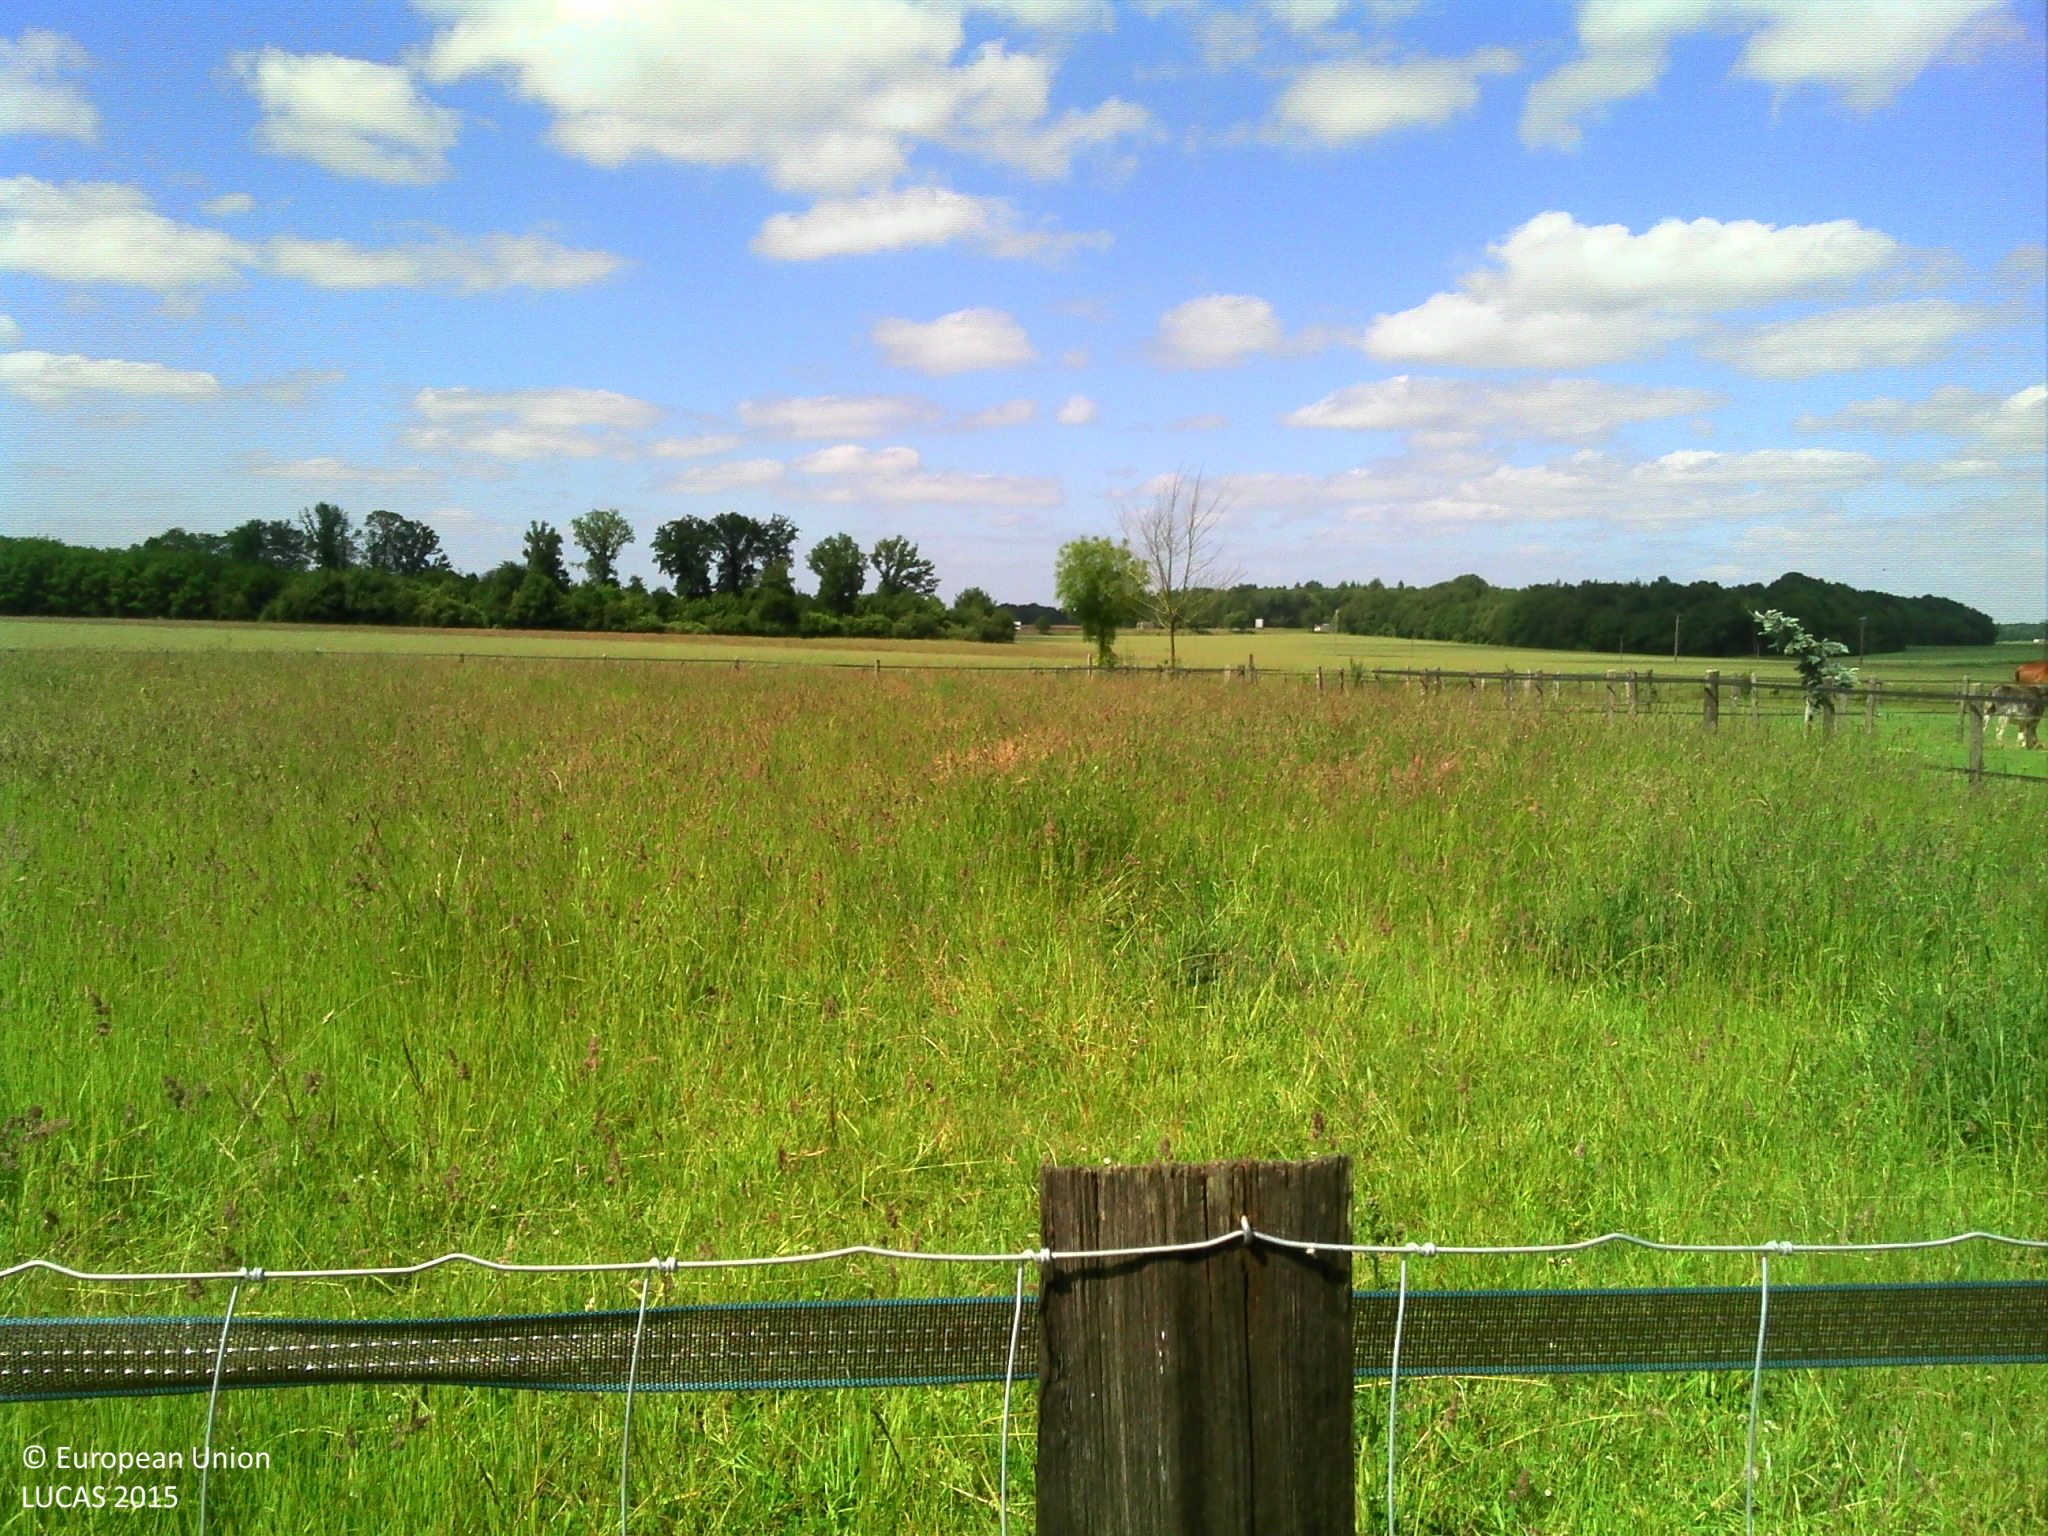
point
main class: Grassland
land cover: Grassland without tree/shrub cover
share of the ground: > 75 %
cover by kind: herbaceous plants 100 %
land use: Agriculture (excluding fallow land and kitchen gardens)
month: June
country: FR
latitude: 47.4747
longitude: 0.7857
